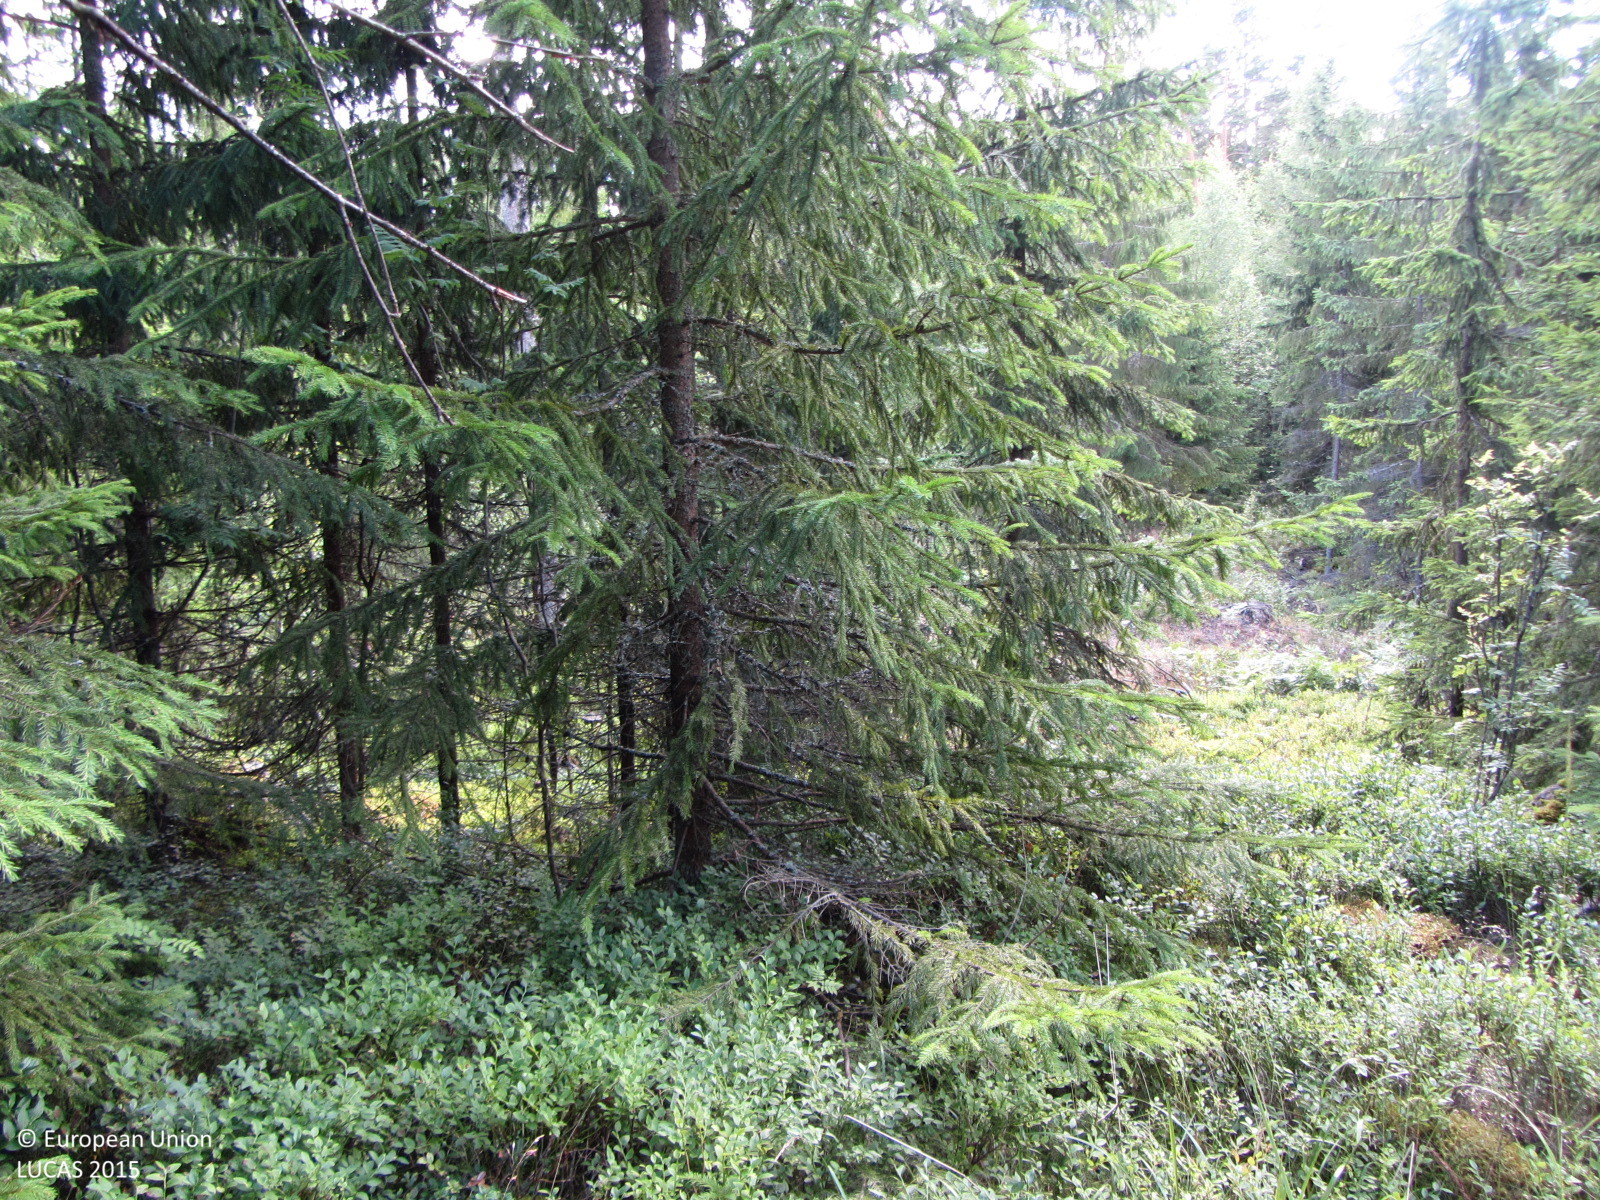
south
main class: Woodland
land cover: Spruce dominated mixed woodland
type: hemiboreal forest and nemoral coniferous forest and mixed broadleaved-coniferous forest
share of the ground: 50 - 75 %
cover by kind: coniferous forest trees 35 %, shrubs 25 %, broadleaved forest trees 20 %, herbaceous plants 20 %
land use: Forestry
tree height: > 5 m
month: July
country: FI
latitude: 60.1980
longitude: 24.4845
